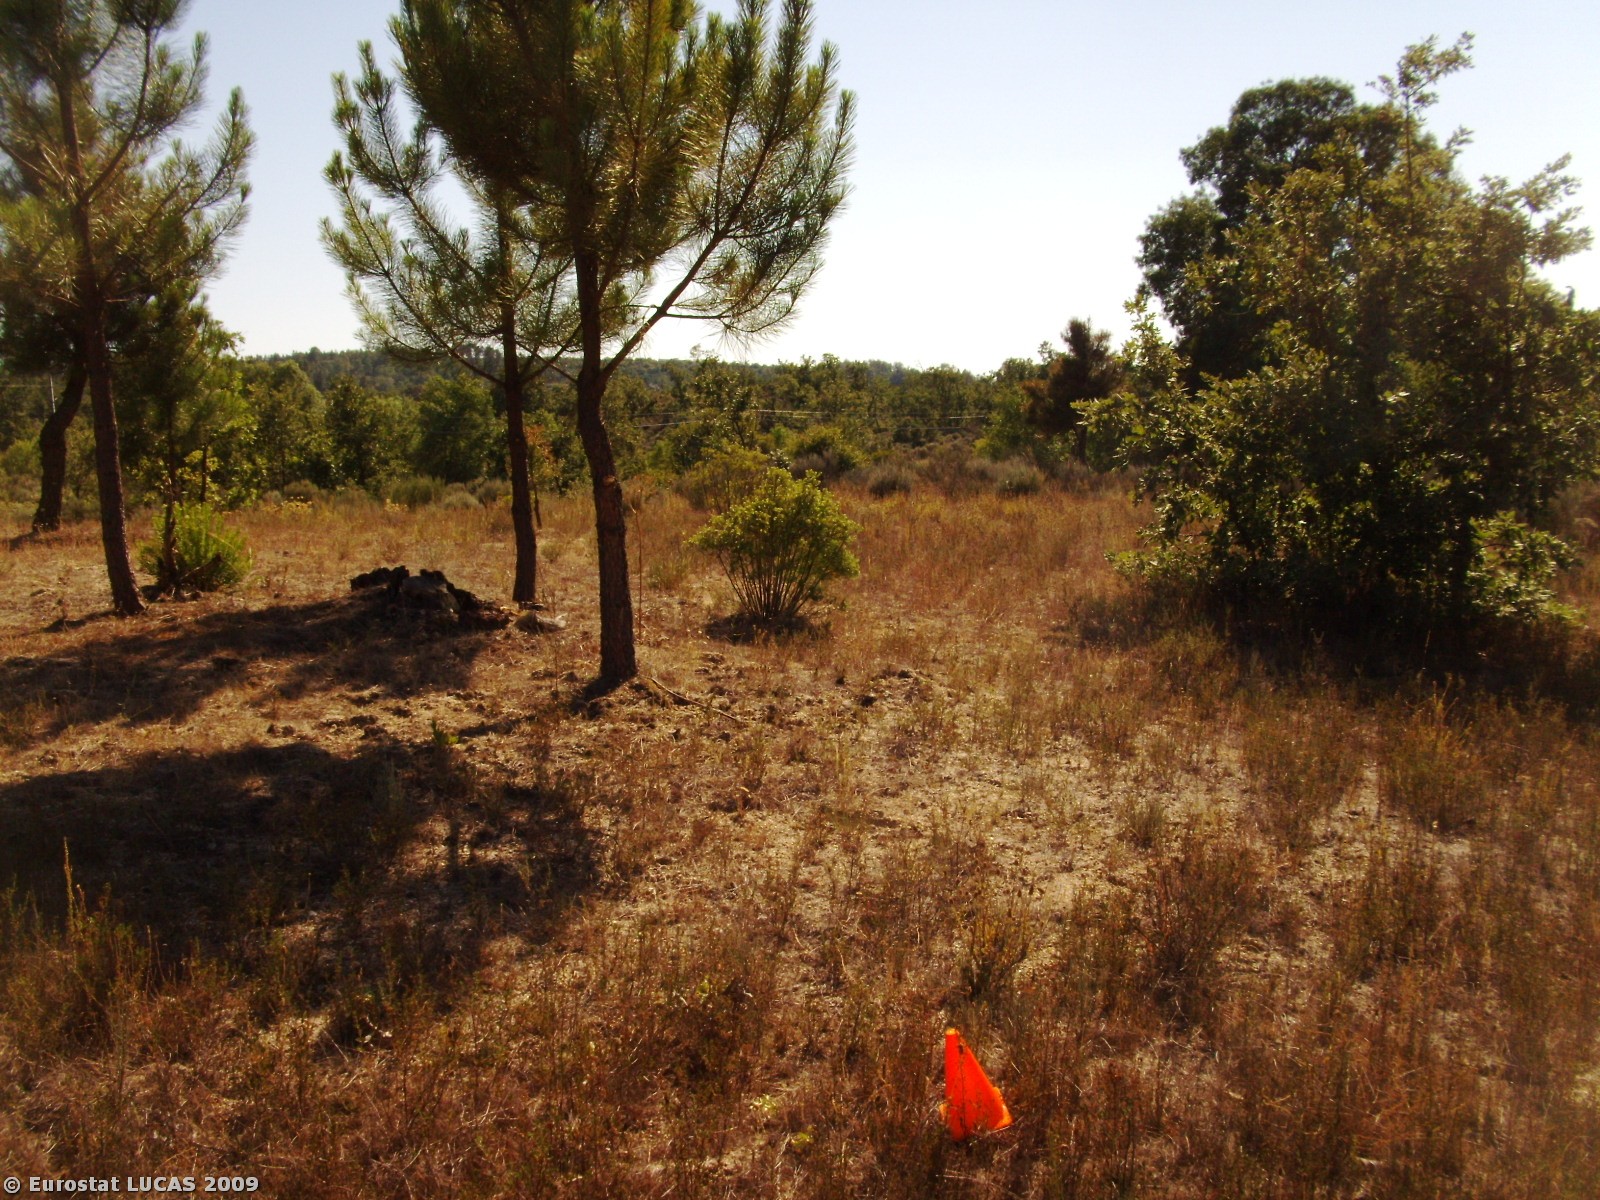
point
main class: Woodland
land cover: Mixed woodland
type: coniferous forest of the mediterranean region
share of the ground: 50 - 75 %
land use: Forestry
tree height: > 5 m
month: July
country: PT
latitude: 40.5164
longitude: -7.0368
